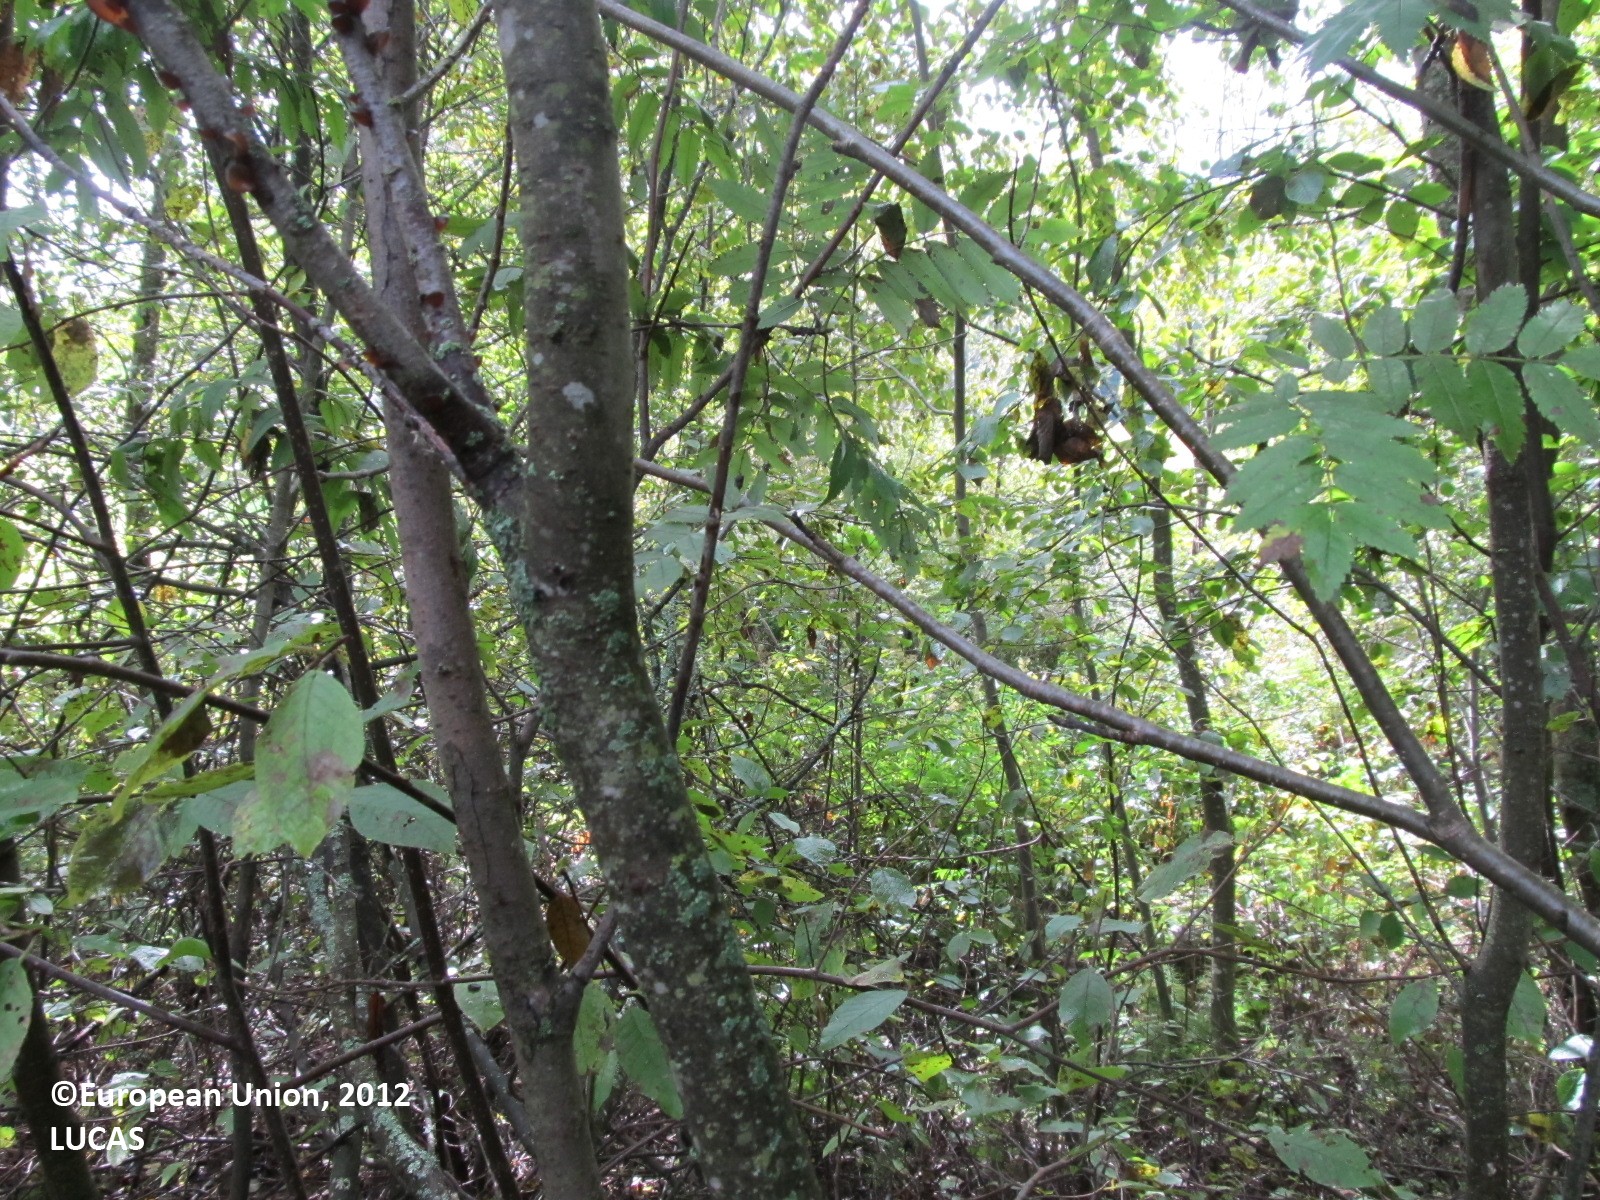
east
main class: Woodland
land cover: Broadleaved woodland
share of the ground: > 75 %
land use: Semi-natural and natural areas not in use
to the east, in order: Broadleaved woodland; Temporary grasslands; Spruce dominated coniferous woodland; Broadleaved woodland; Inland water bodies; Broadleaved woodland; Artificial constructions in urban areas; Broadleaved woodland
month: September
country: FI
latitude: 62.8857
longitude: 28.1806
